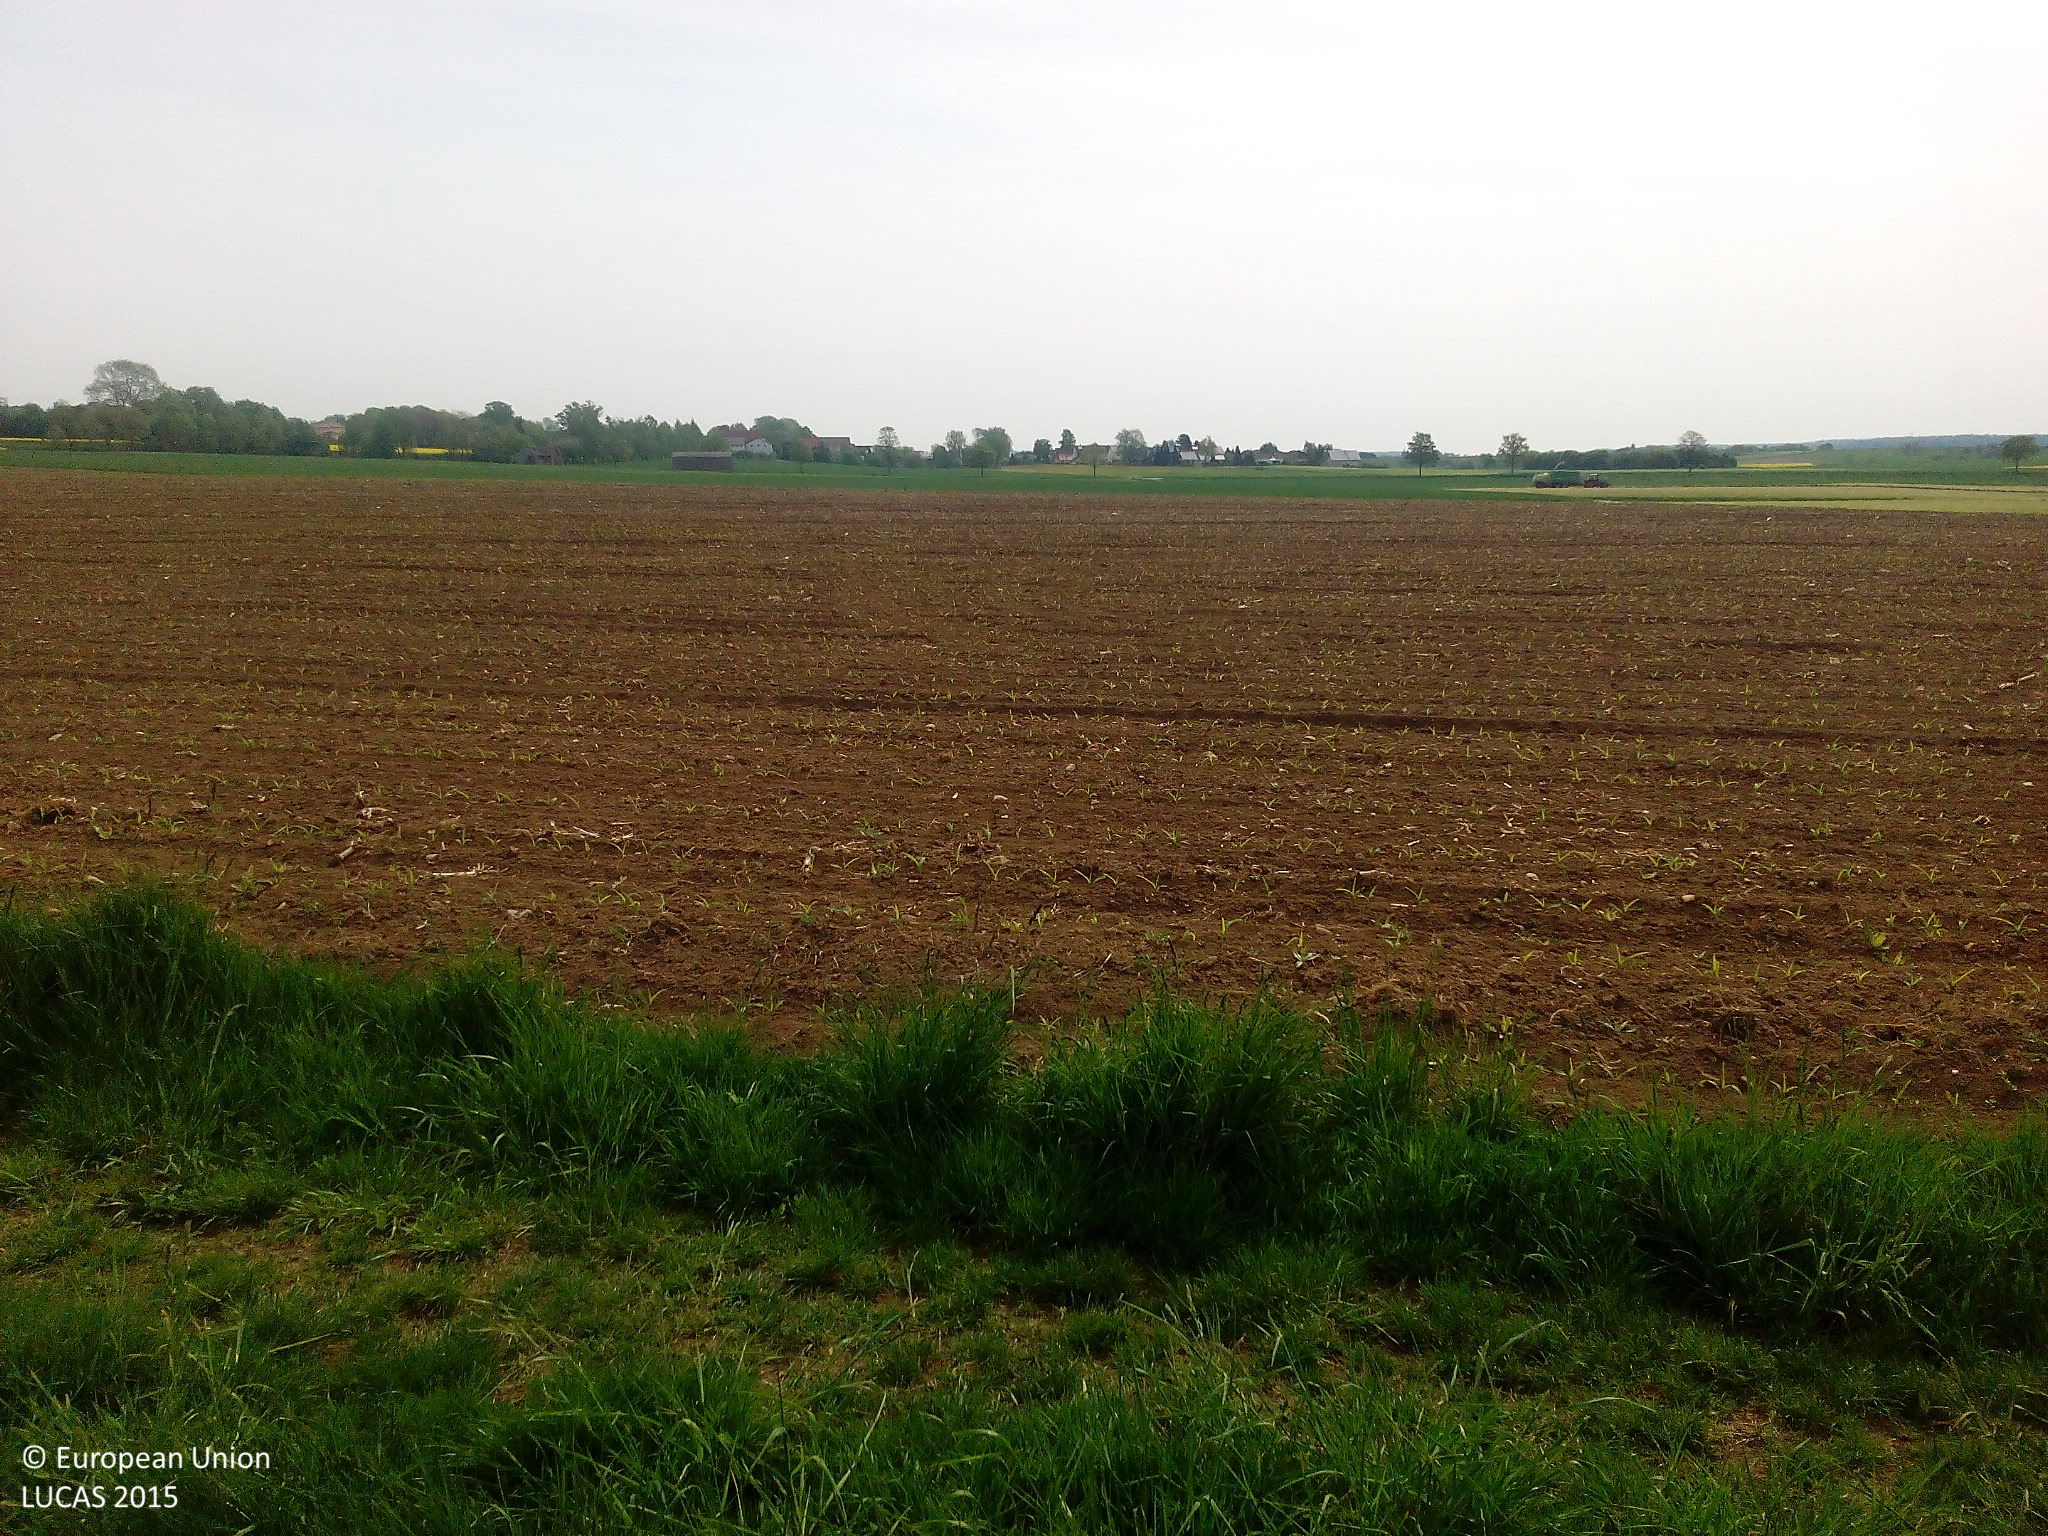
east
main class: Cropland
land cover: Oats
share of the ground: > 75 %
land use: Agriculture (excluding fallow land and kitchen gardens)
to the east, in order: Oats; Tracks; Maize; Common wheat
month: May
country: DE
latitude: 50.3062
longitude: 10.9405
